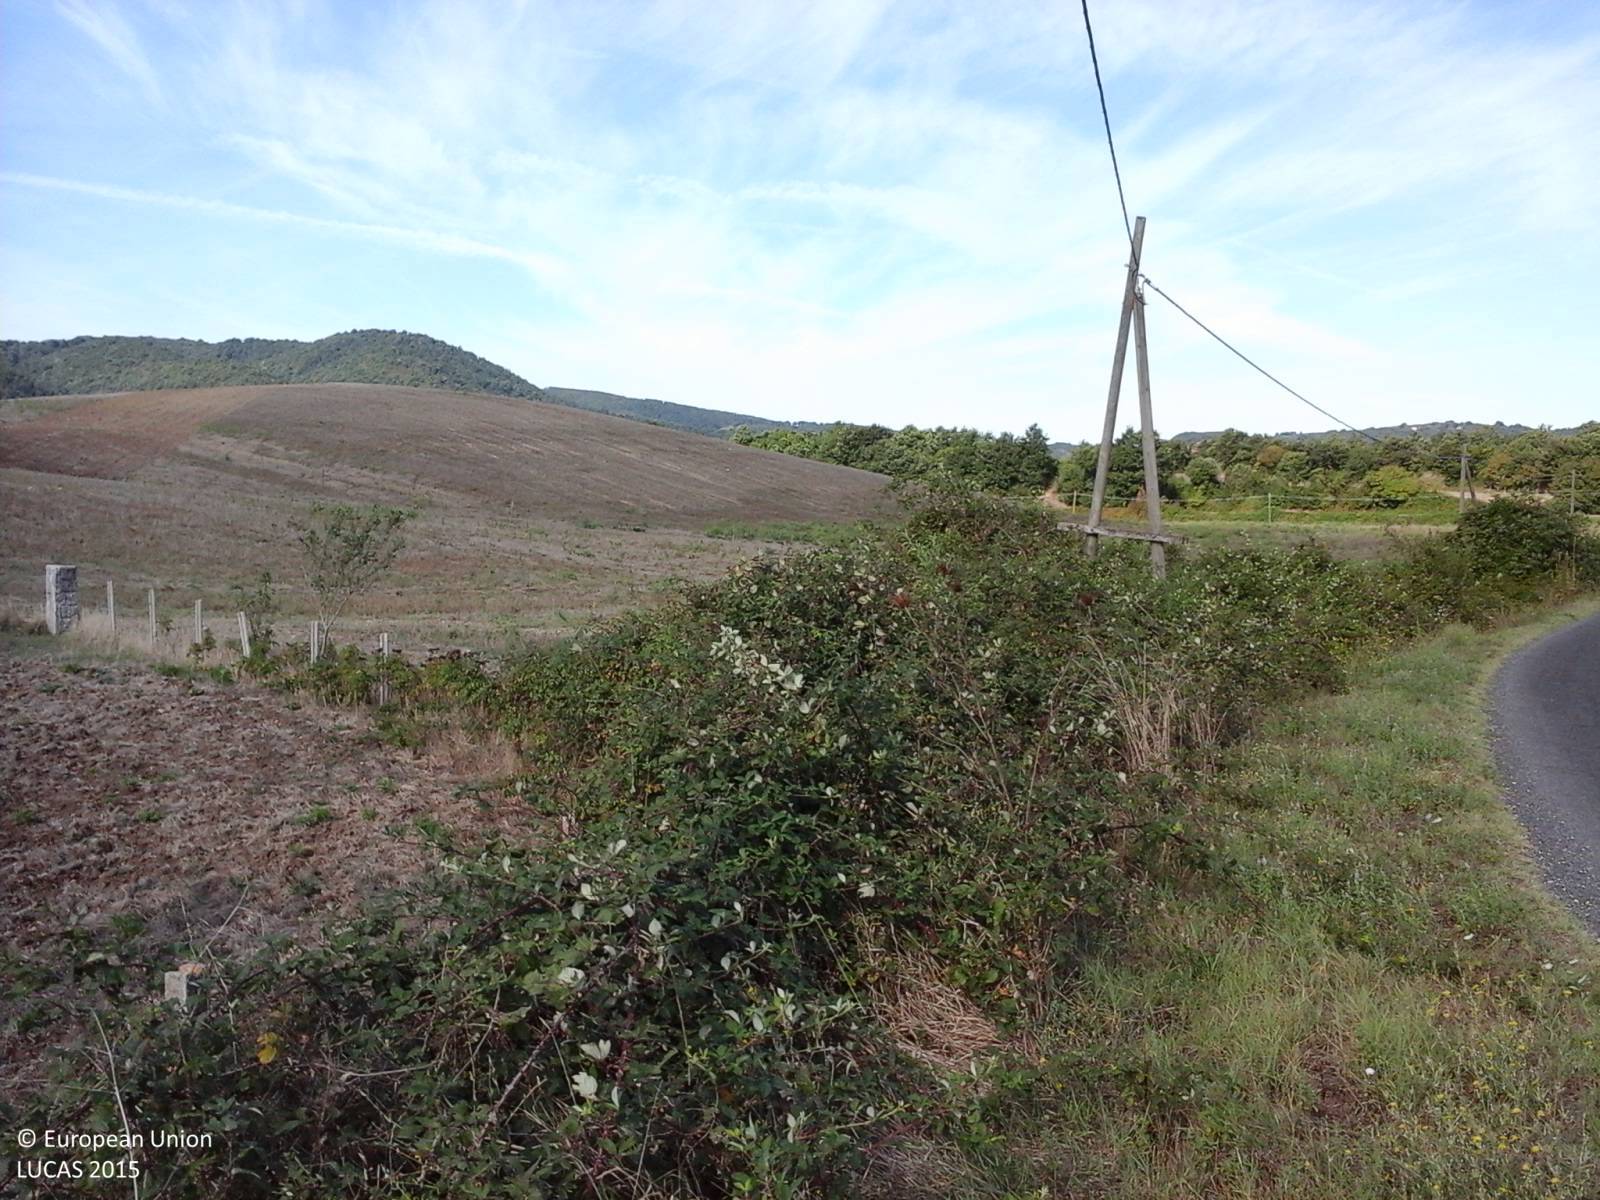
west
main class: Cropland
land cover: Temporary grasslands
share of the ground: > 75 %
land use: Agriculture (excluding fallow land and kitchen gardens)
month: September
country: IT
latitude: 42.5328
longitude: 11.6138
